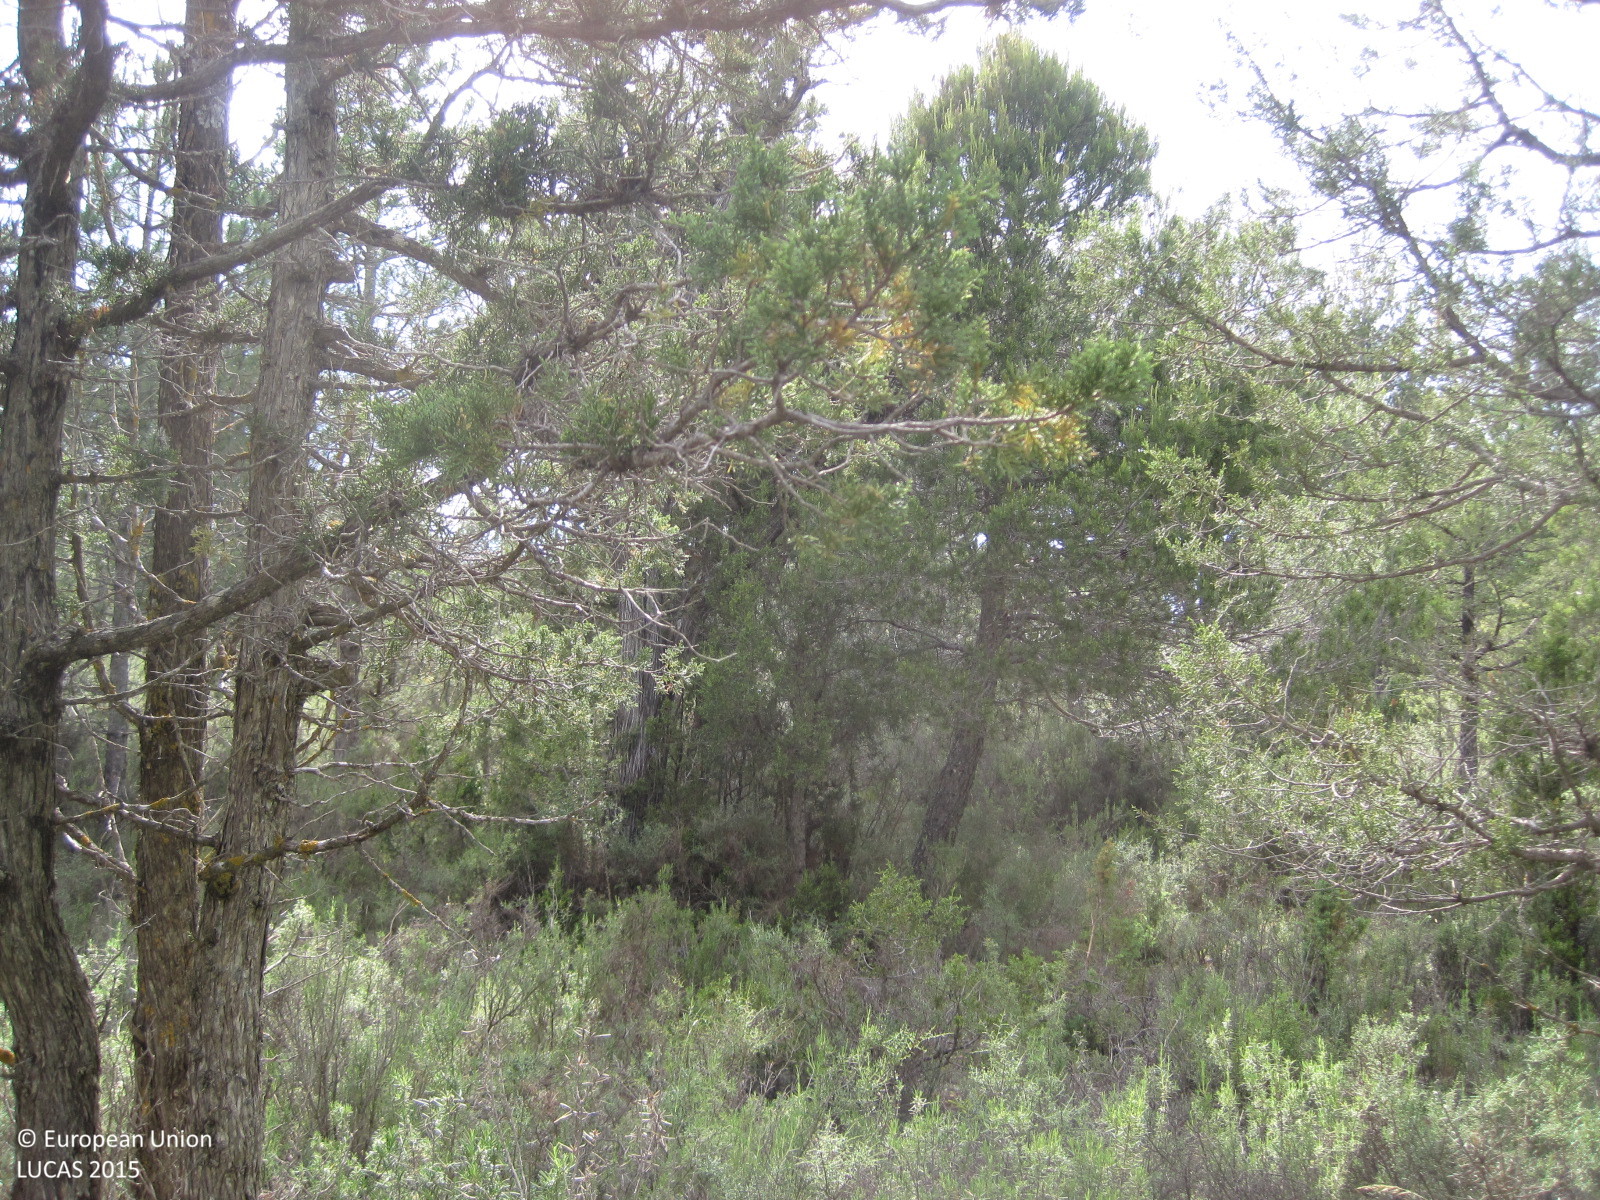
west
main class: Woodland
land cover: Other coniferous woodland
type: coniferous forest of the mediterranean region
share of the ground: 50 - 75 %
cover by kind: coniferous forest trees 55 %, shrubs 25 %, herbaceous plants 15 %, lichens and mosses 5 %
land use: Forestry
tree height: > 5 m
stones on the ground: 25 - 50 %
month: June
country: ES
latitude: 39.9573
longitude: -0.9977
